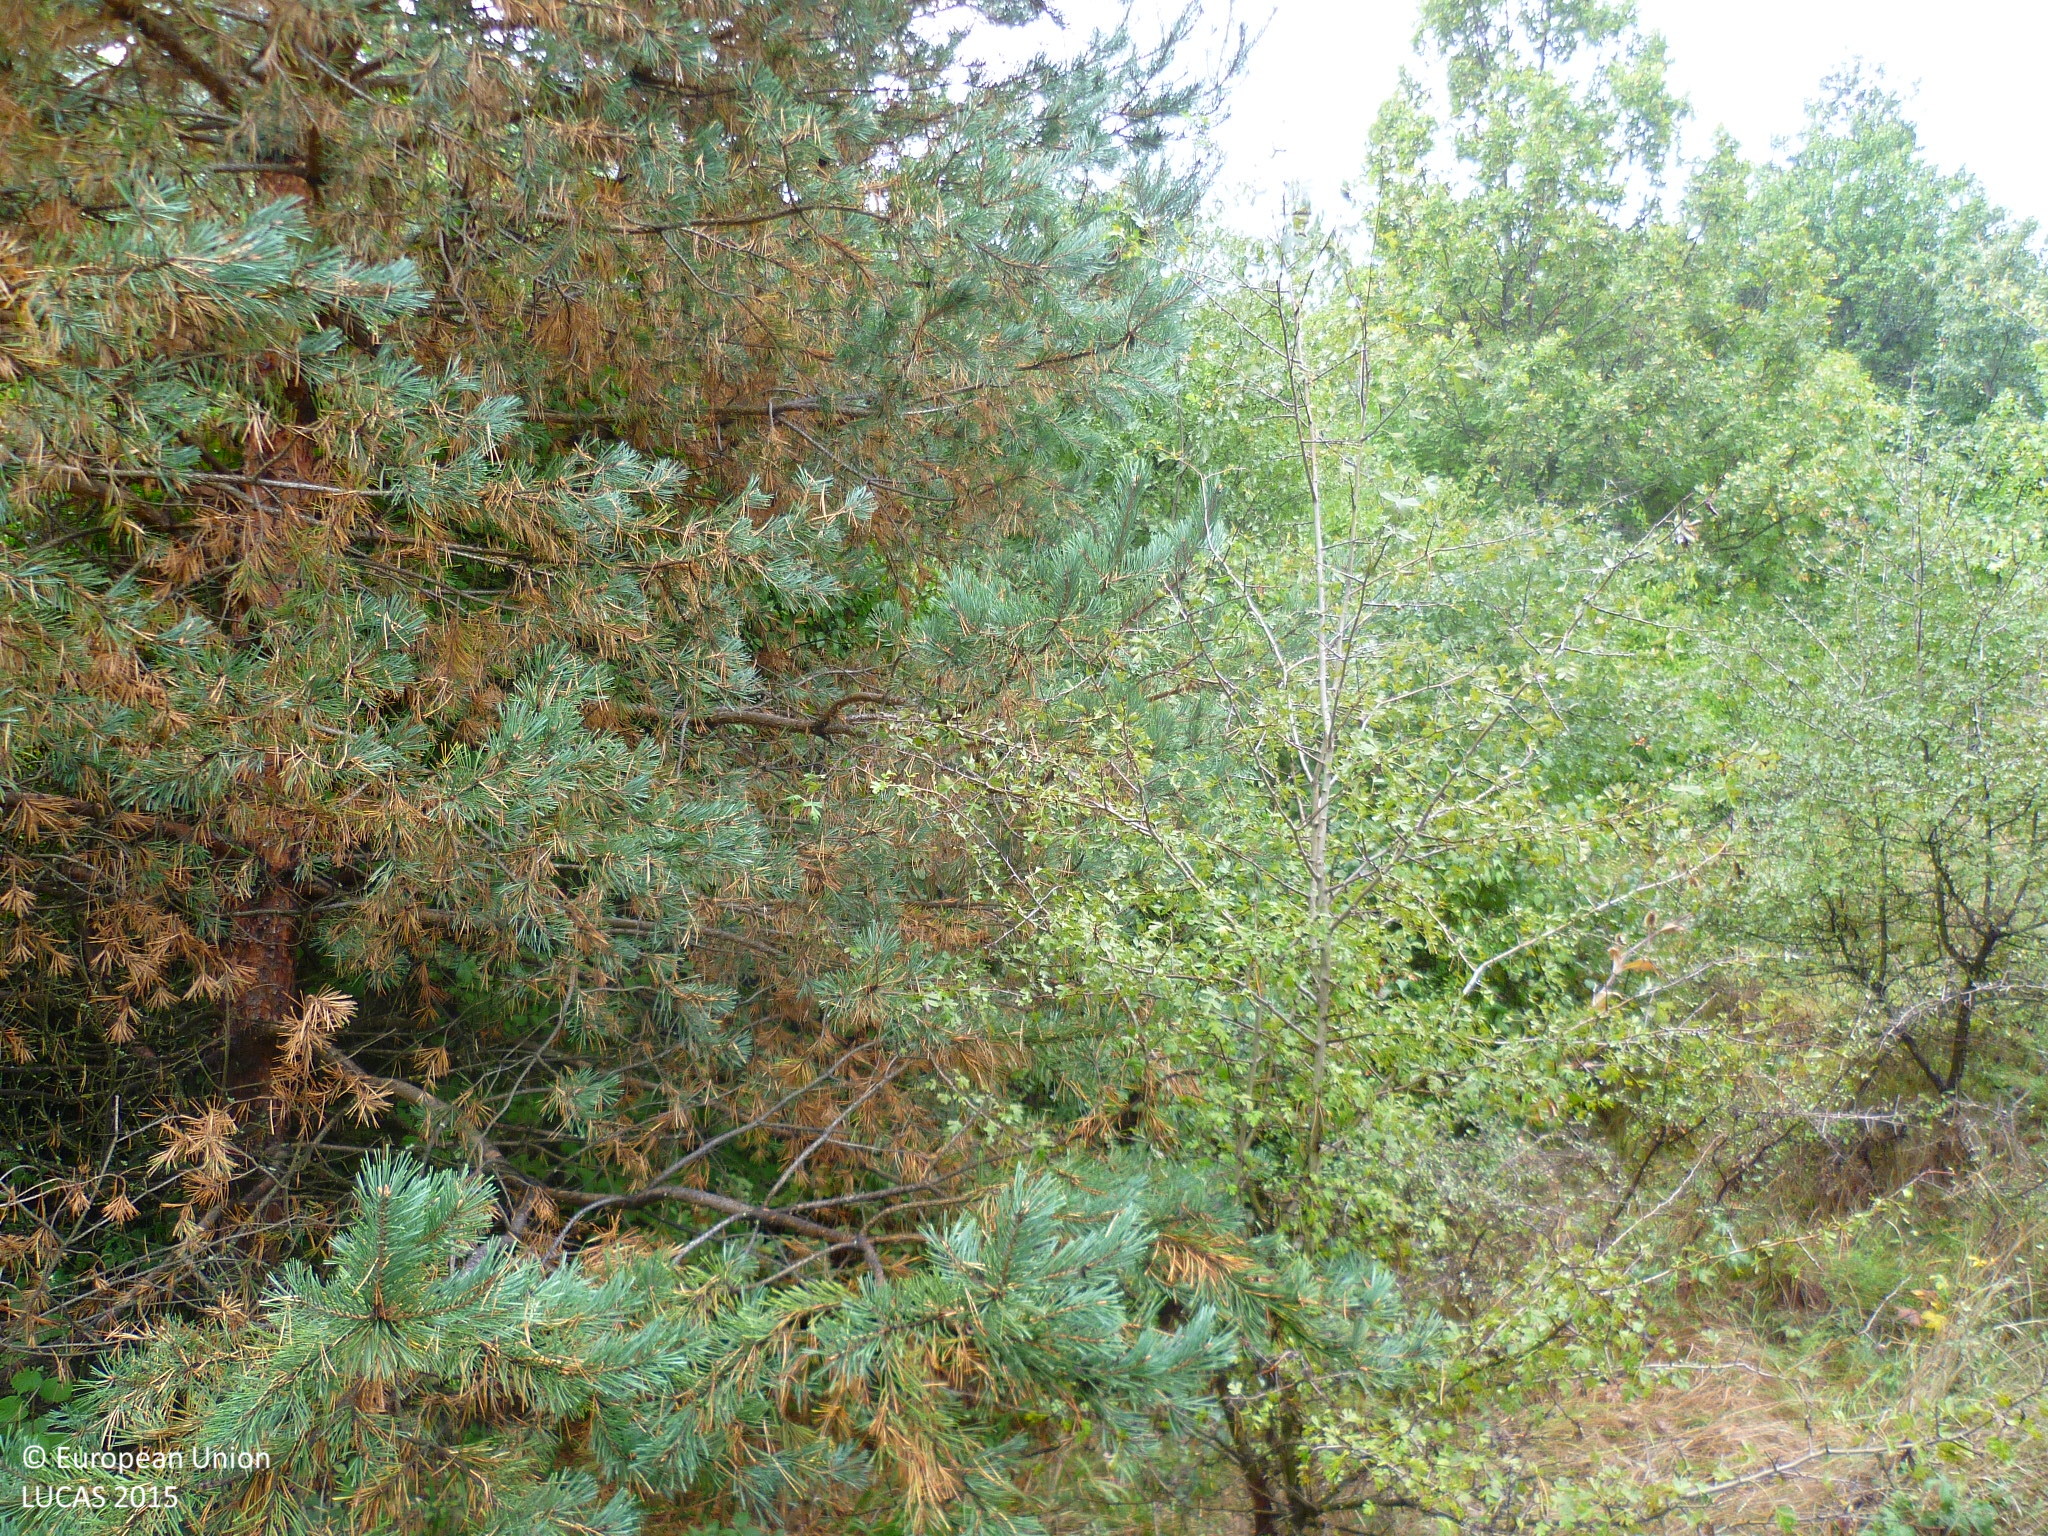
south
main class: Woodland
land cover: Pine dominated mixed woodland
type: hemiboreal forest and nemoral coniferous forest and mixed broadleaved-coniferous forest
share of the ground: > 75 %
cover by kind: coniferous forest trees 50 %, broadleaved forest trees 35 %, herbaceous plants 10 %, shrubs 5 %
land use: Forestry
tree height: > 5 m
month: September
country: BG
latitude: 42.6483
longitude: 22.7478
